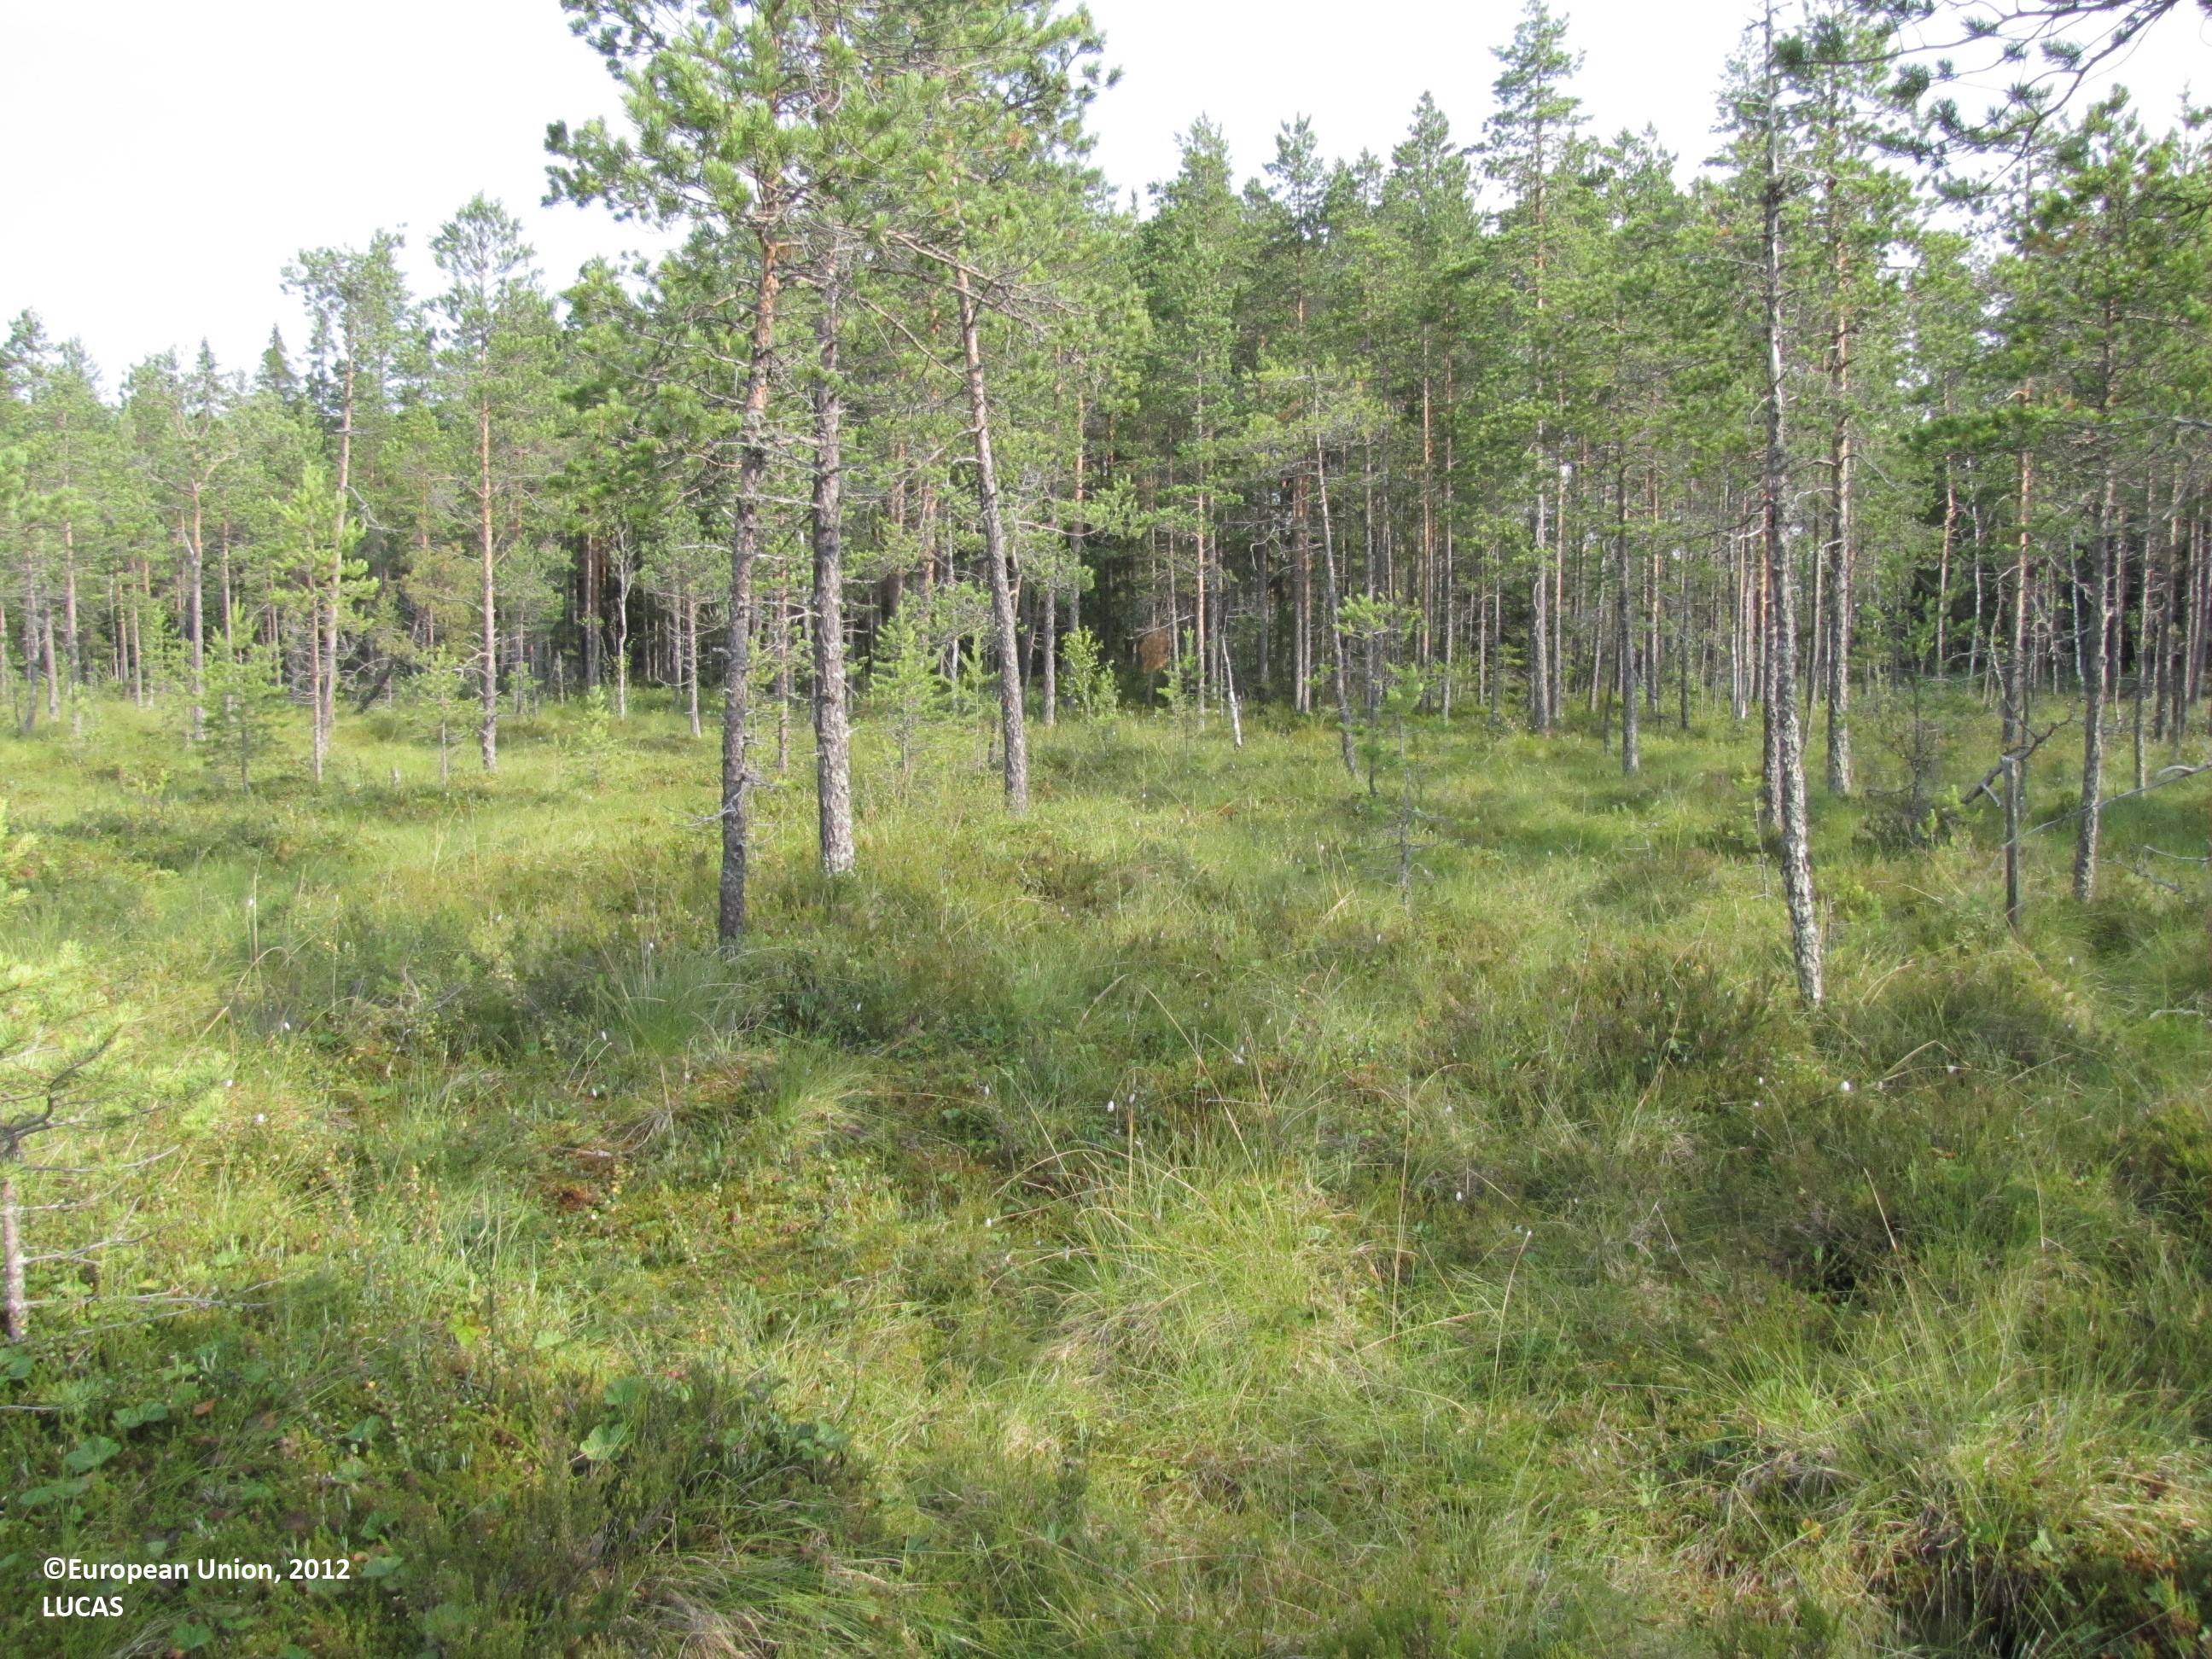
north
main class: Woodland
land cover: Pine dominated coniferous woodland
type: mire and swamp forests
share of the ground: 25 - 50 %
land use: Community services
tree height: < 5 m
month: July
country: FI
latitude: 62.0566
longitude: 23.2896
